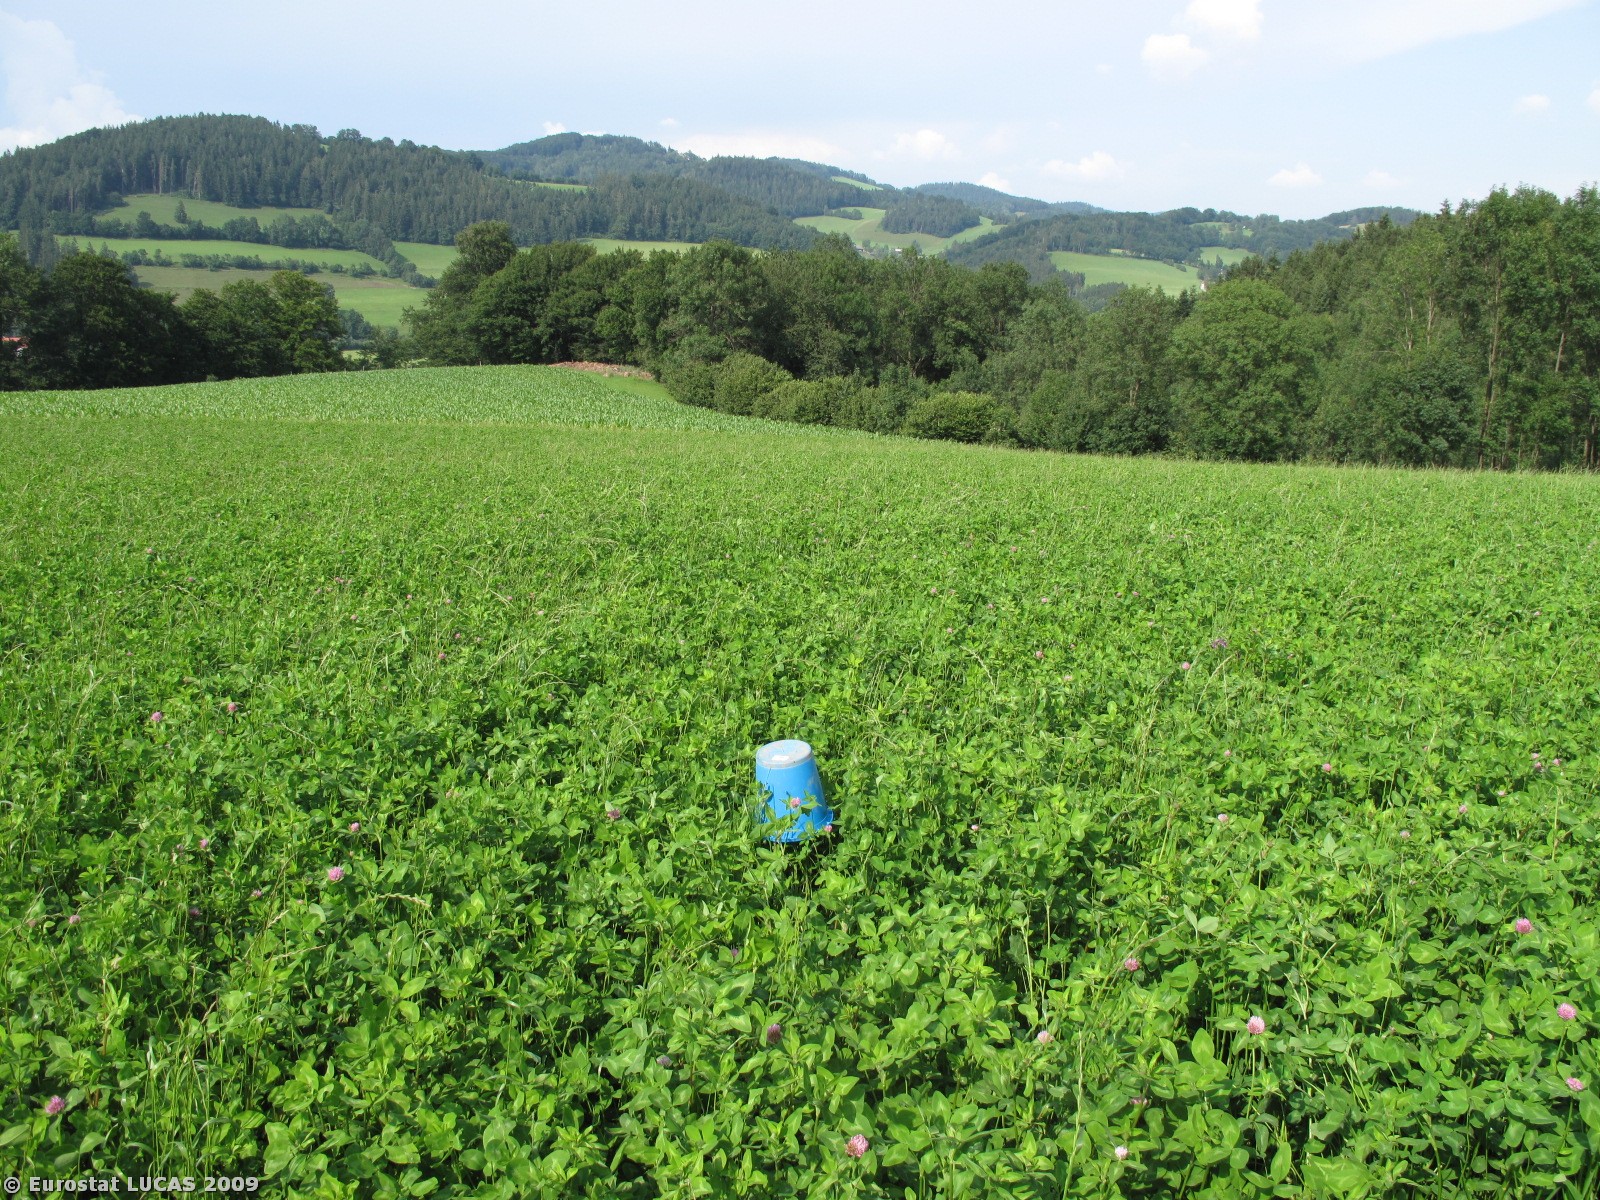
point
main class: Cropland
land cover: Clovers
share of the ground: > 75 %
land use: Agriculture (excluding fallow land and kitchen gardens)
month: July
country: AT
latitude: 48.0426
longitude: 15.6495
